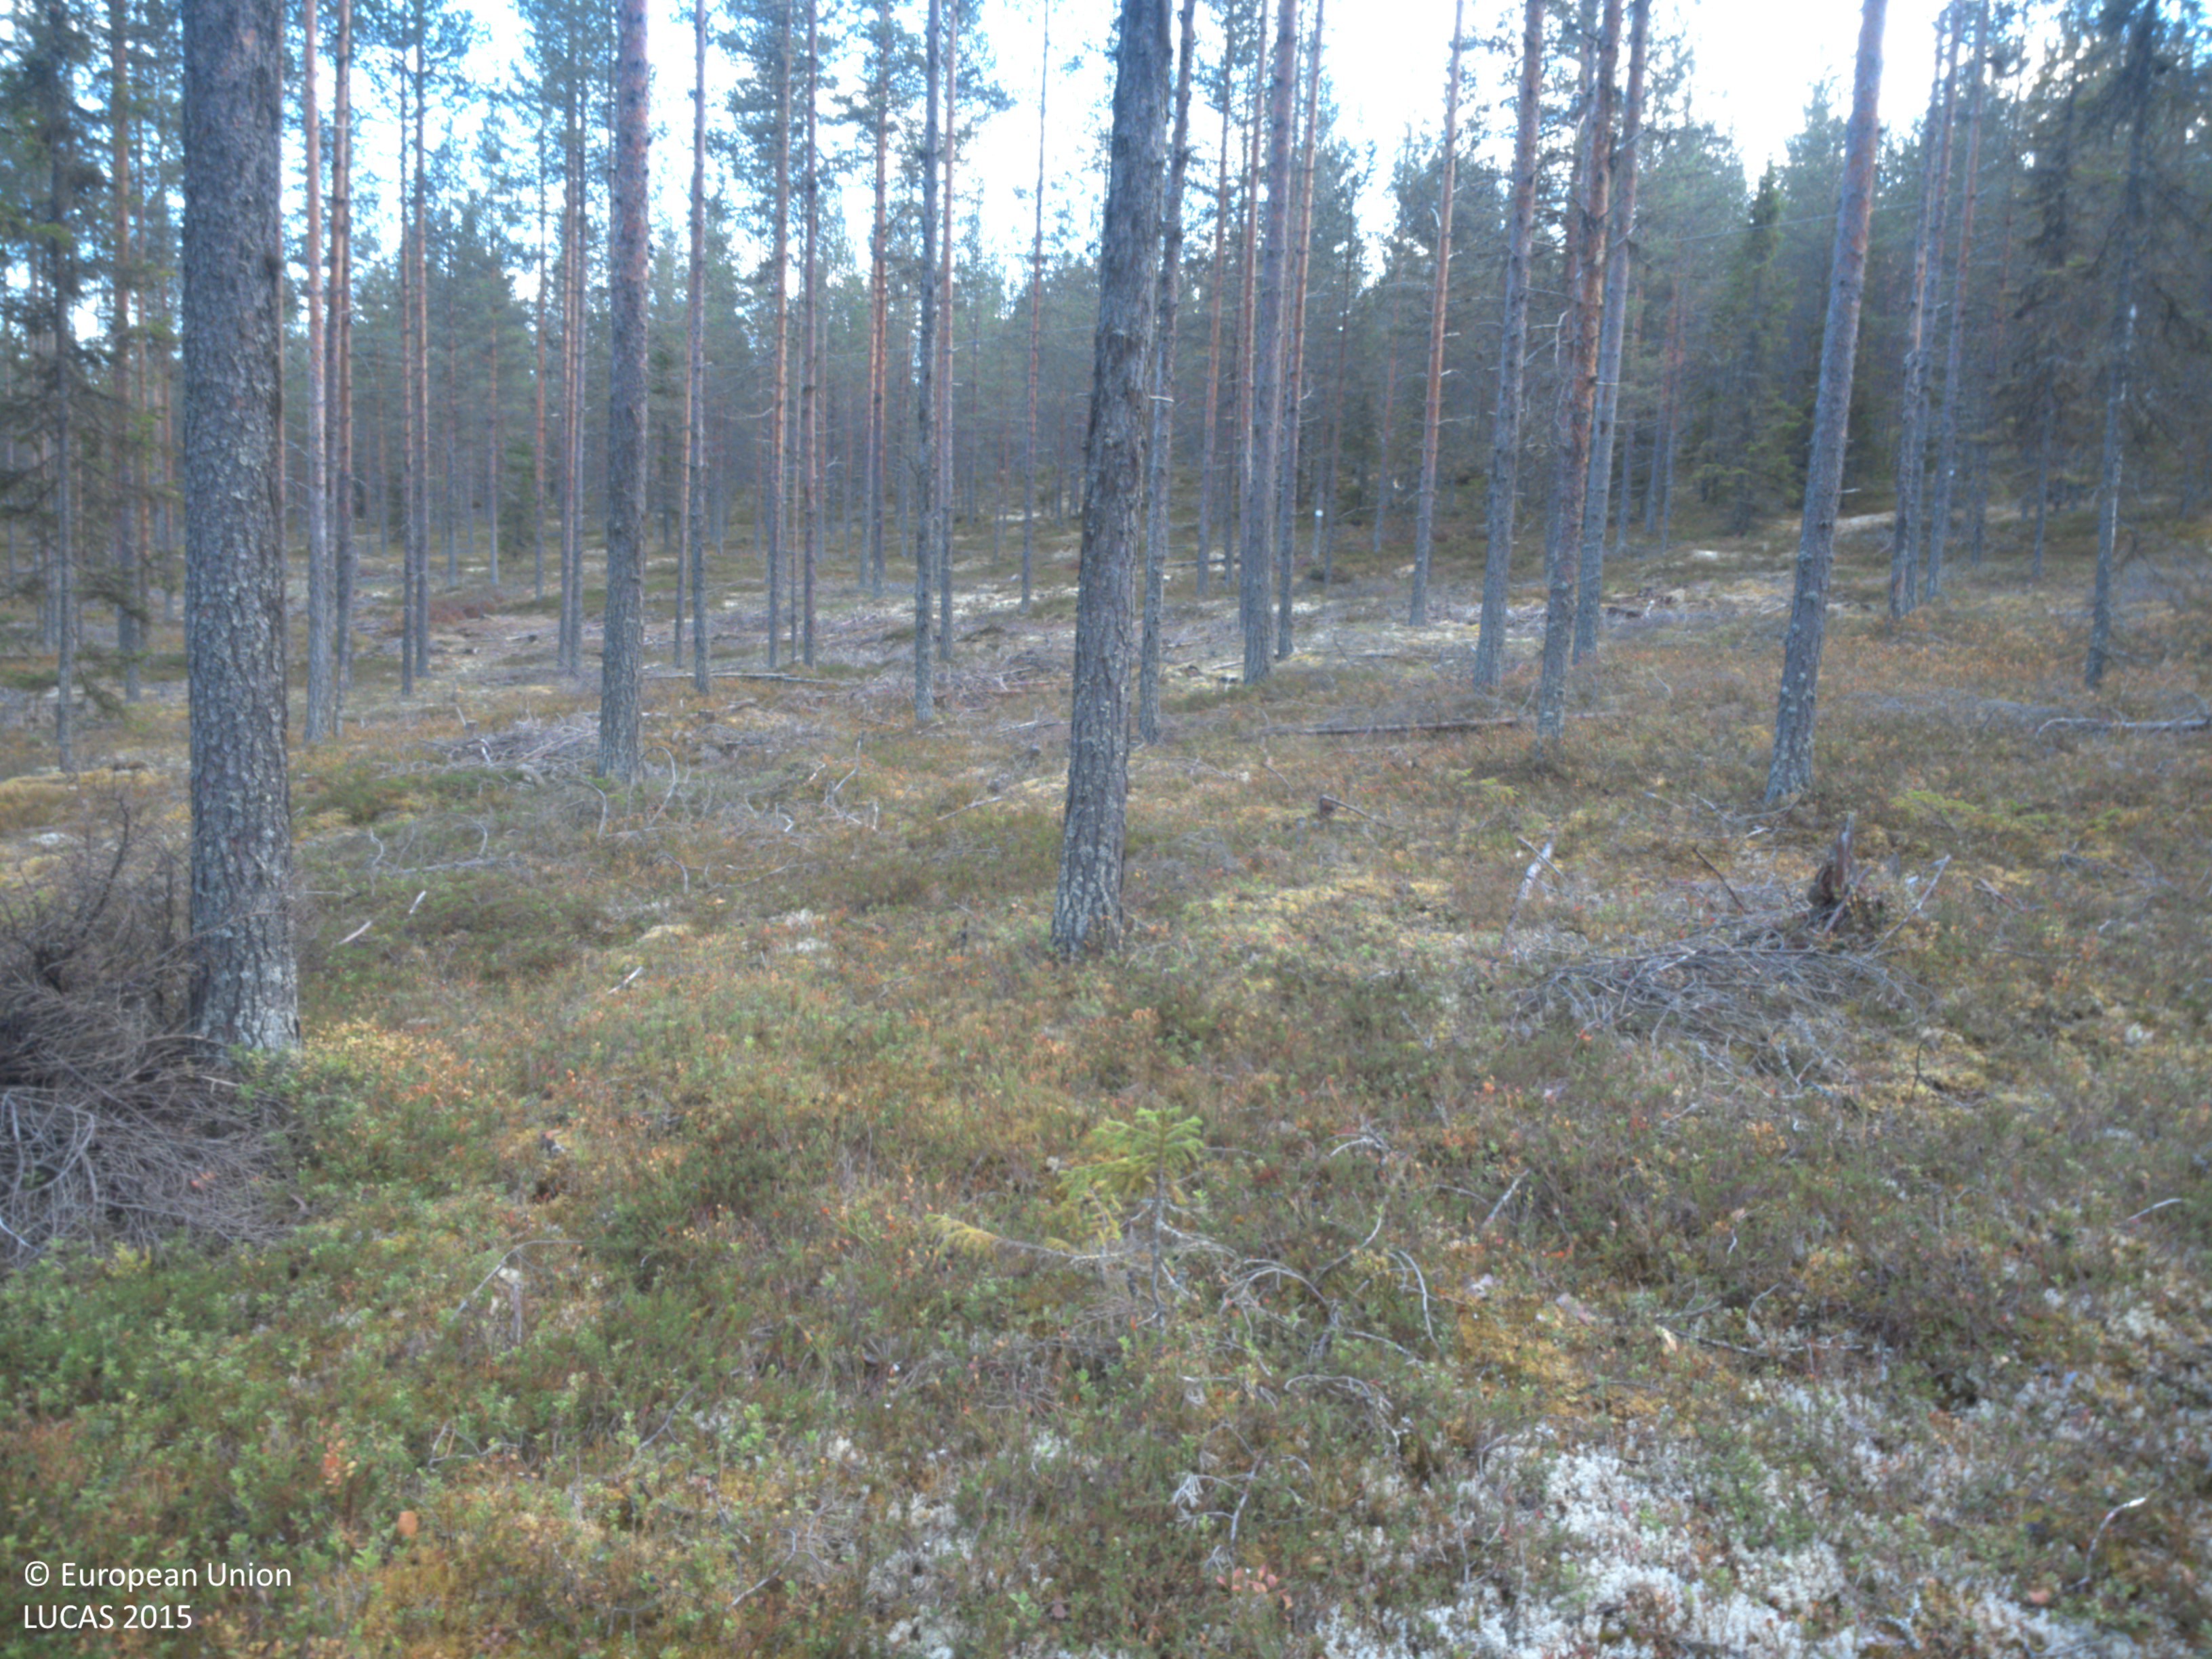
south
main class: Woodland
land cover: Pine dominated coniferous woodland
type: boreal forest
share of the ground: 50 - 75 %
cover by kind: coniferous forest trees 75 %, shrubs 10 %, lichens and mosses 10 %, herbaceous plants 5 %
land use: Forestry
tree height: > 5 m
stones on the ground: < 10 %
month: October
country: SE
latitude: 63.9529
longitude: 18.8117
